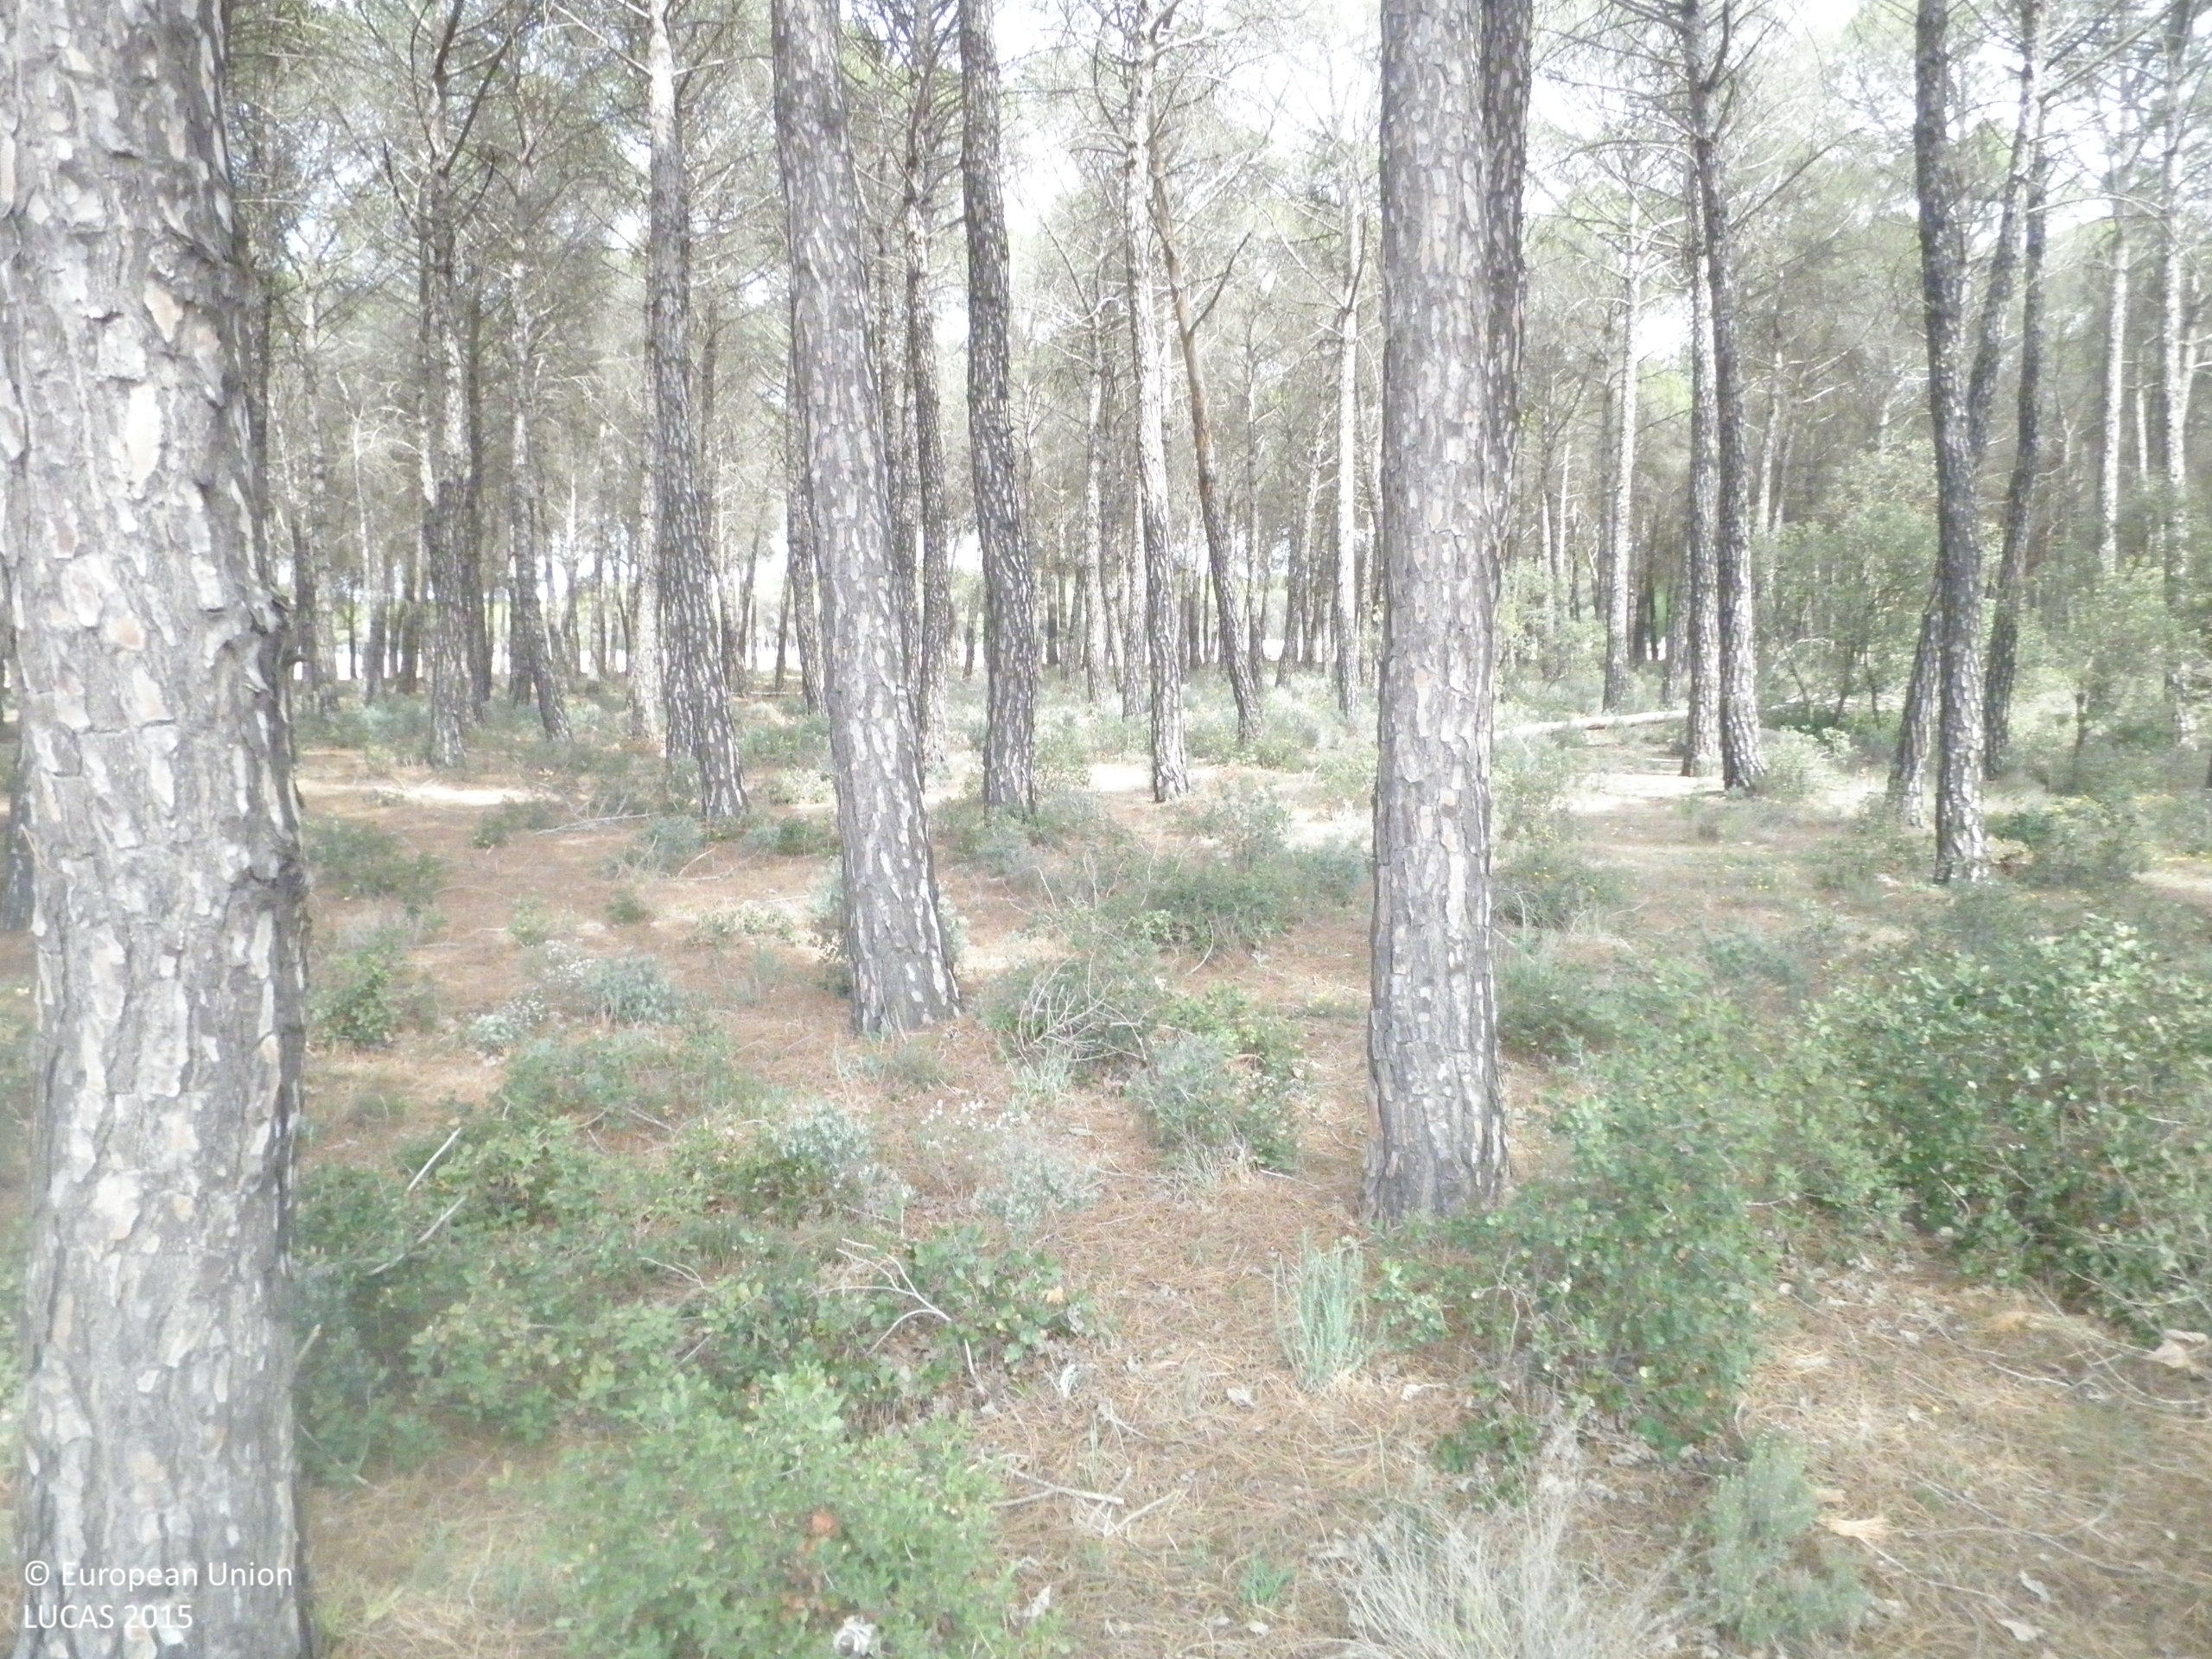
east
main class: Woodland
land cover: Pine dominated coniferous woodland
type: coniferous forest of the mediterranean region
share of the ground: > 75 %
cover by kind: coniferous forest trees 70 %, shrubs 10 %, herbaceous plants 10 %, unconsolidated bare surface 10 %
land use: Semi-natural and natural areas not in use
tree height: > 5 m
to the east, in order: Pine dominated coniferous woodland; Tracks; Vineyards; Pine dominated coniferous woodland
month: April
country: ES
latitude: 39.3862
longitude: -2.6789
